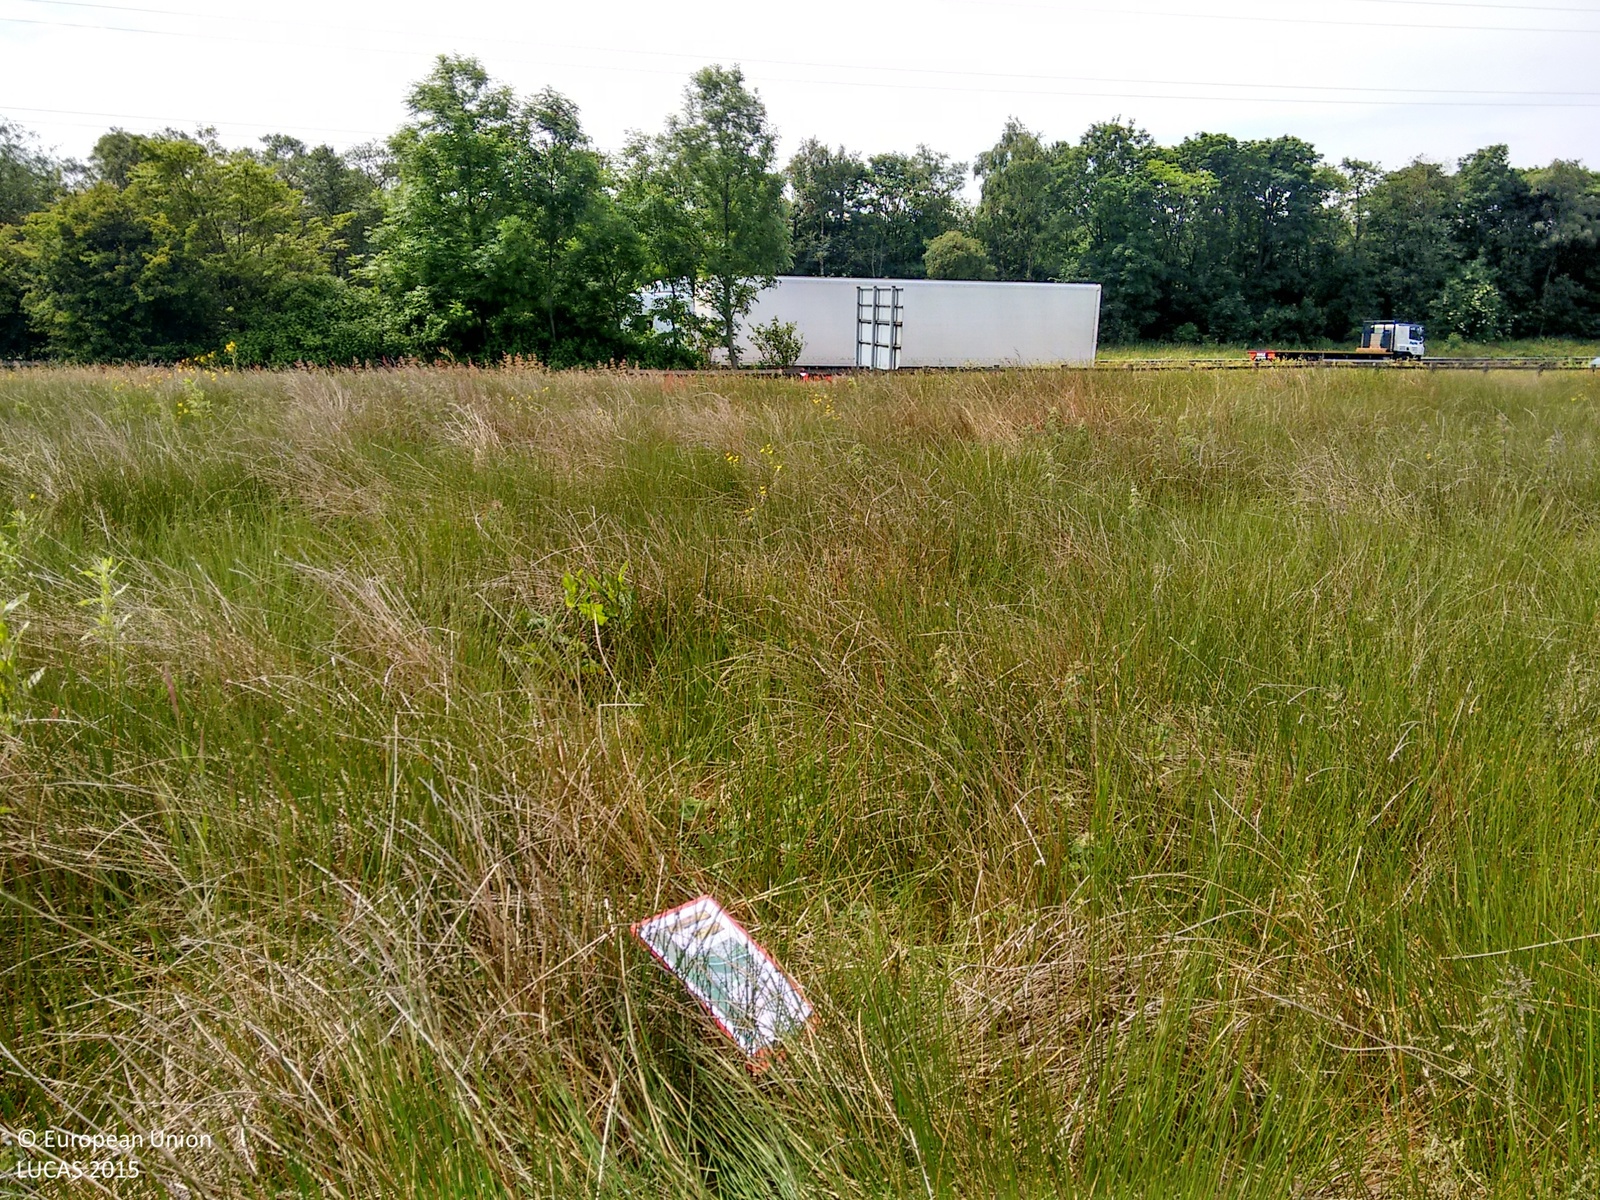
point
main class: Grassland
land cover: Grassland without tree/shrub cover
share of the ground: > 75 %
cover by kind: herbaceous plants 100 %
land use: Semi-natural and natural areas not in use
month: June
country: GB
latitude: 53.5418
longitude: -2.4231
